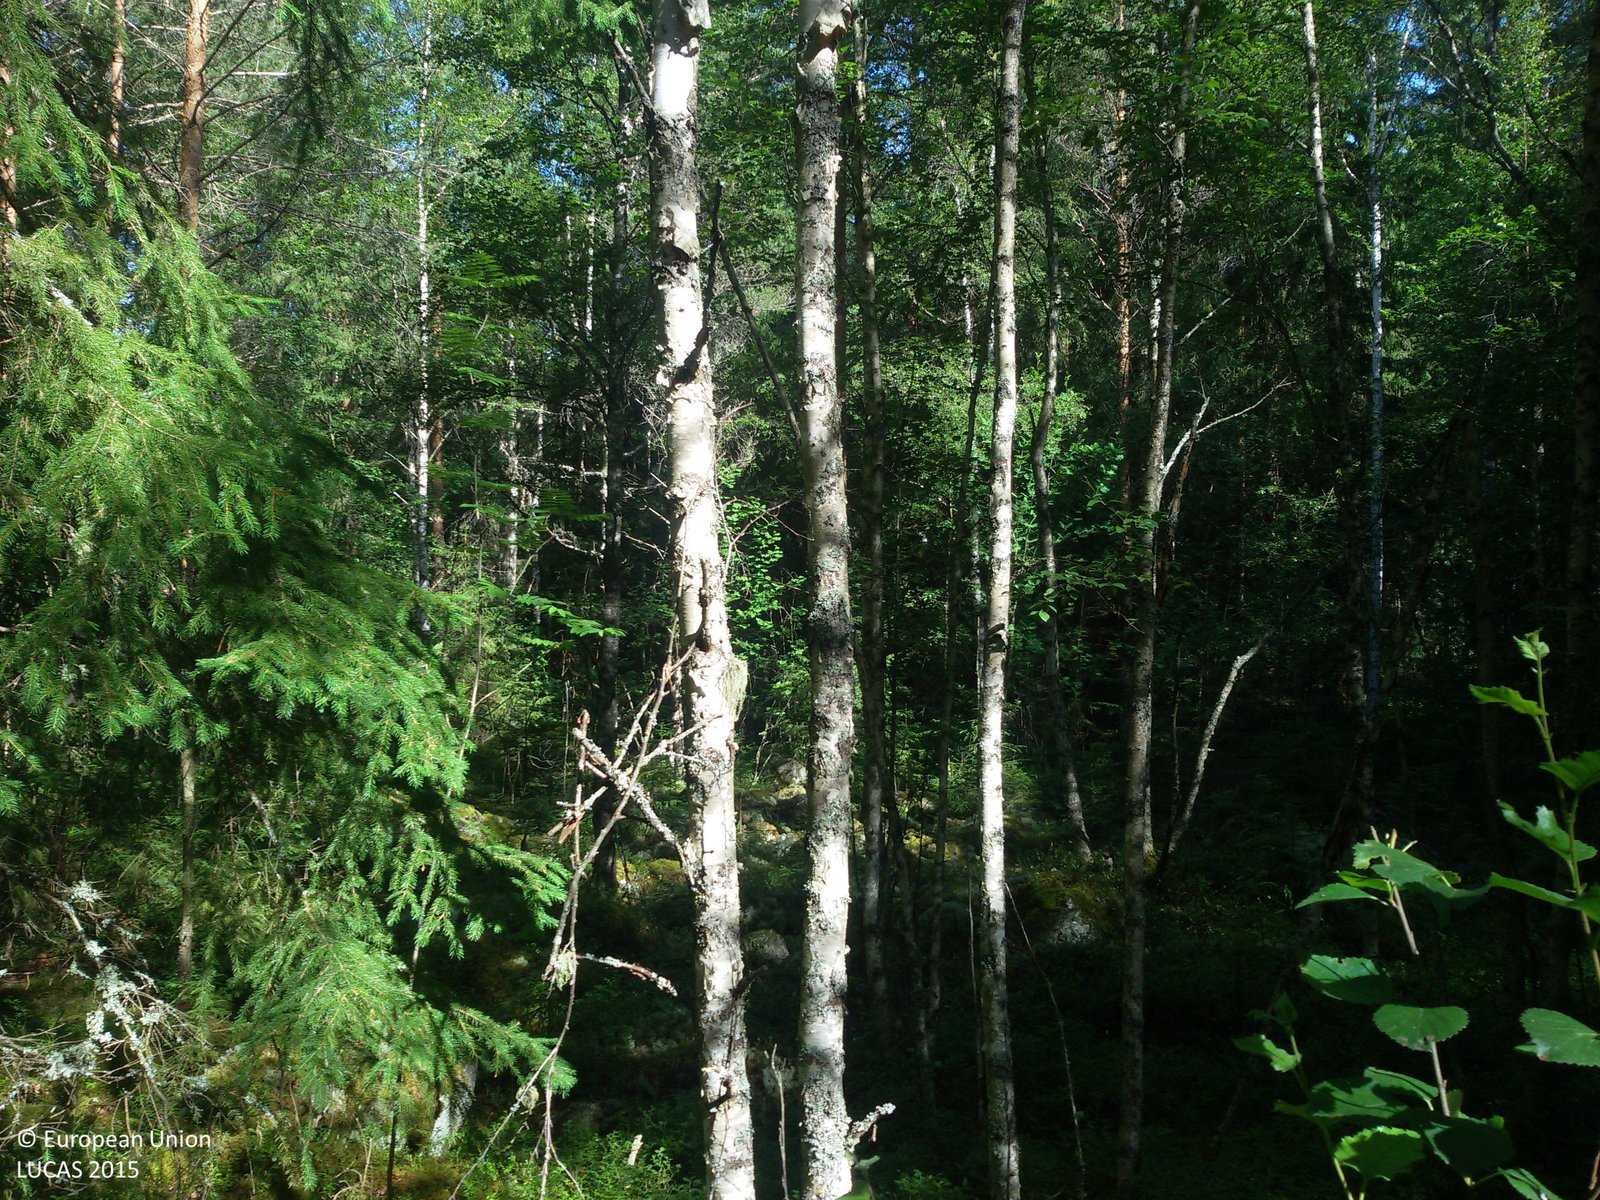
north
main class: Woodland
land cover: Pine dominated mixed woodland
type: boreal forest
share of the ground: > 75 %
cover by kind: coniferous forest trees 50 %, broadleaved forest trees 30 %, herbaceous plants 10 %, lichens and mosses 10 %
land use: Forestry
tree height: > 5 m
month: July
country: SE
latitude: 60.6623
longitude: 15.2018
